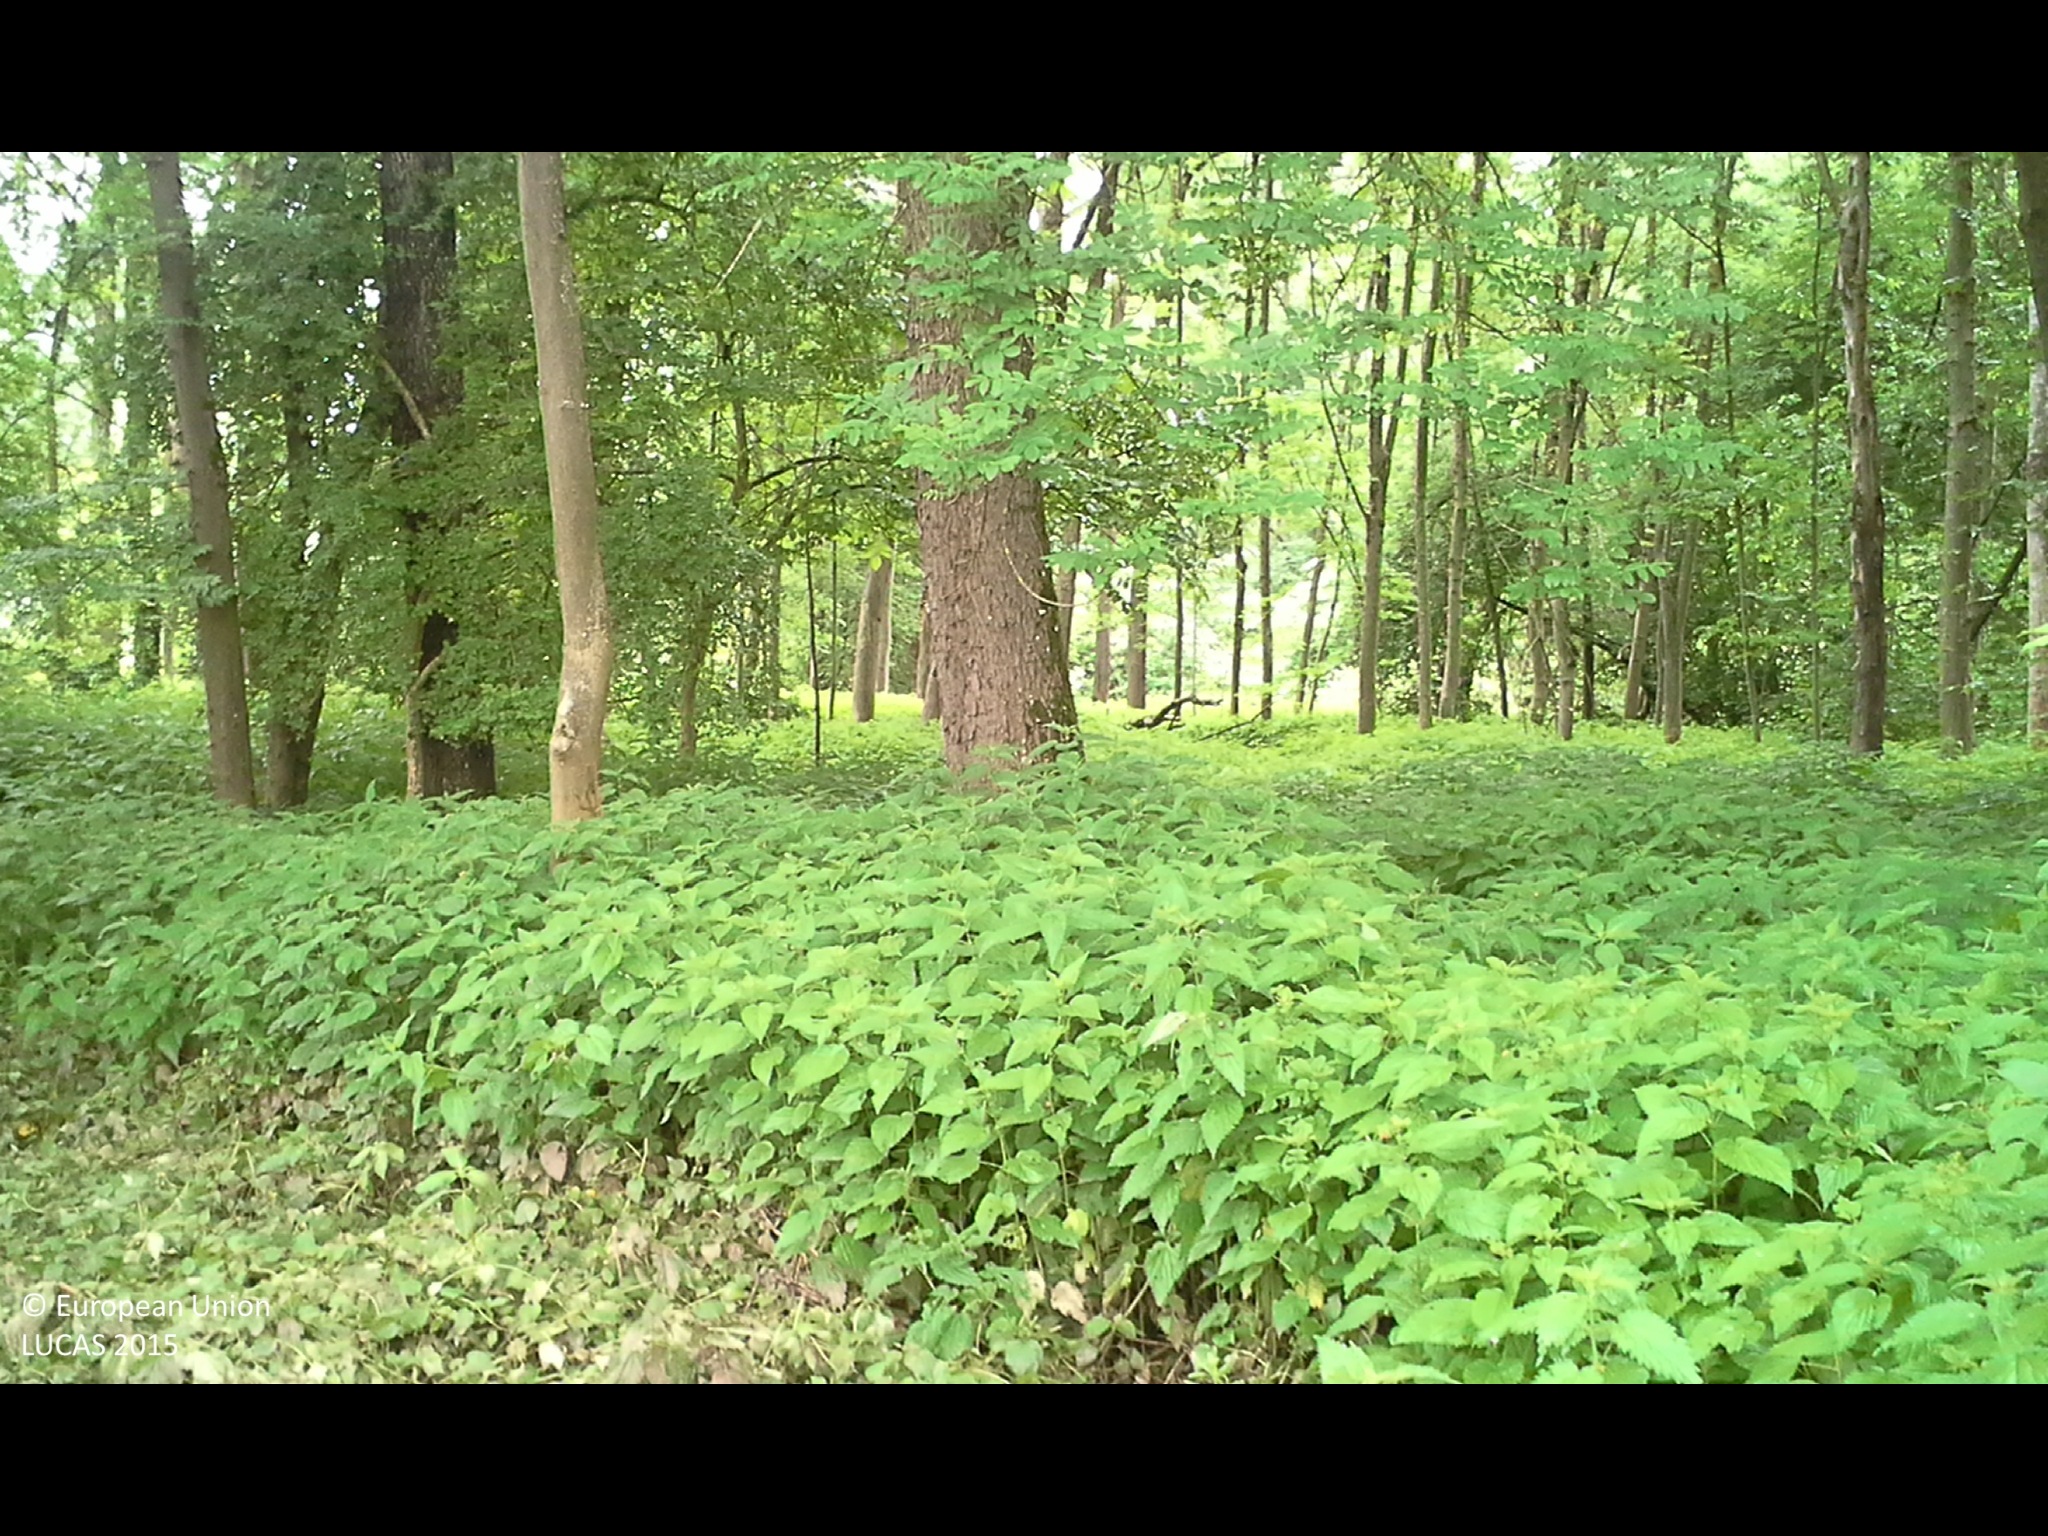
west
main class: Woodland
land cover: Broadleaved woodland
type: floodplain forest
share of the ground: > 75 %
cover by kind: broadleaved forest trees 100 %
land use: Forestry
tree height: > 5 m
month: May
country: AT
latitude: 48.2300
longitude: 14.2946
